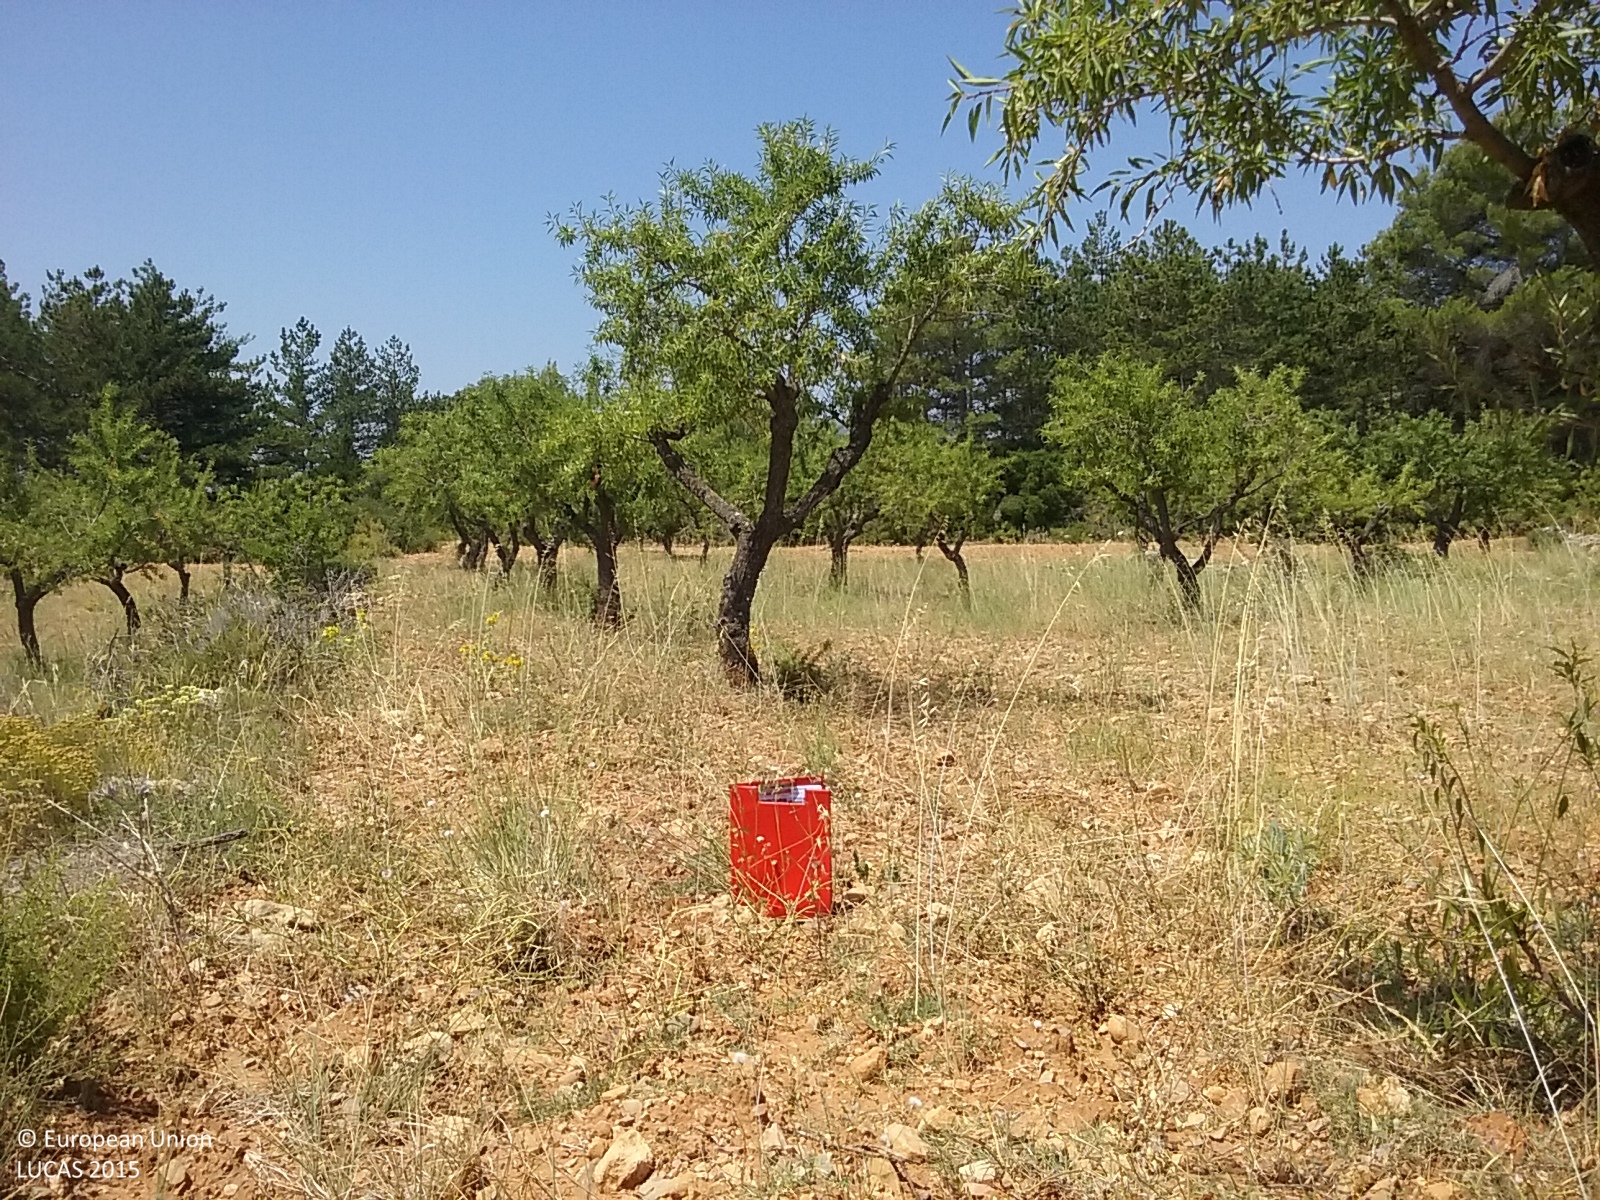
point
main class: Cropland
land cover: Nuts trees
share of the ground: 10 - 25 %
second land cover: Spontaneously vegetated surfaces
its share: 25 - 50 %
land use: Agriculture (excluding fallow land and kitchen gardens)
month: July
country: ES
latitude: 39.9371
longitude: -0.6882
